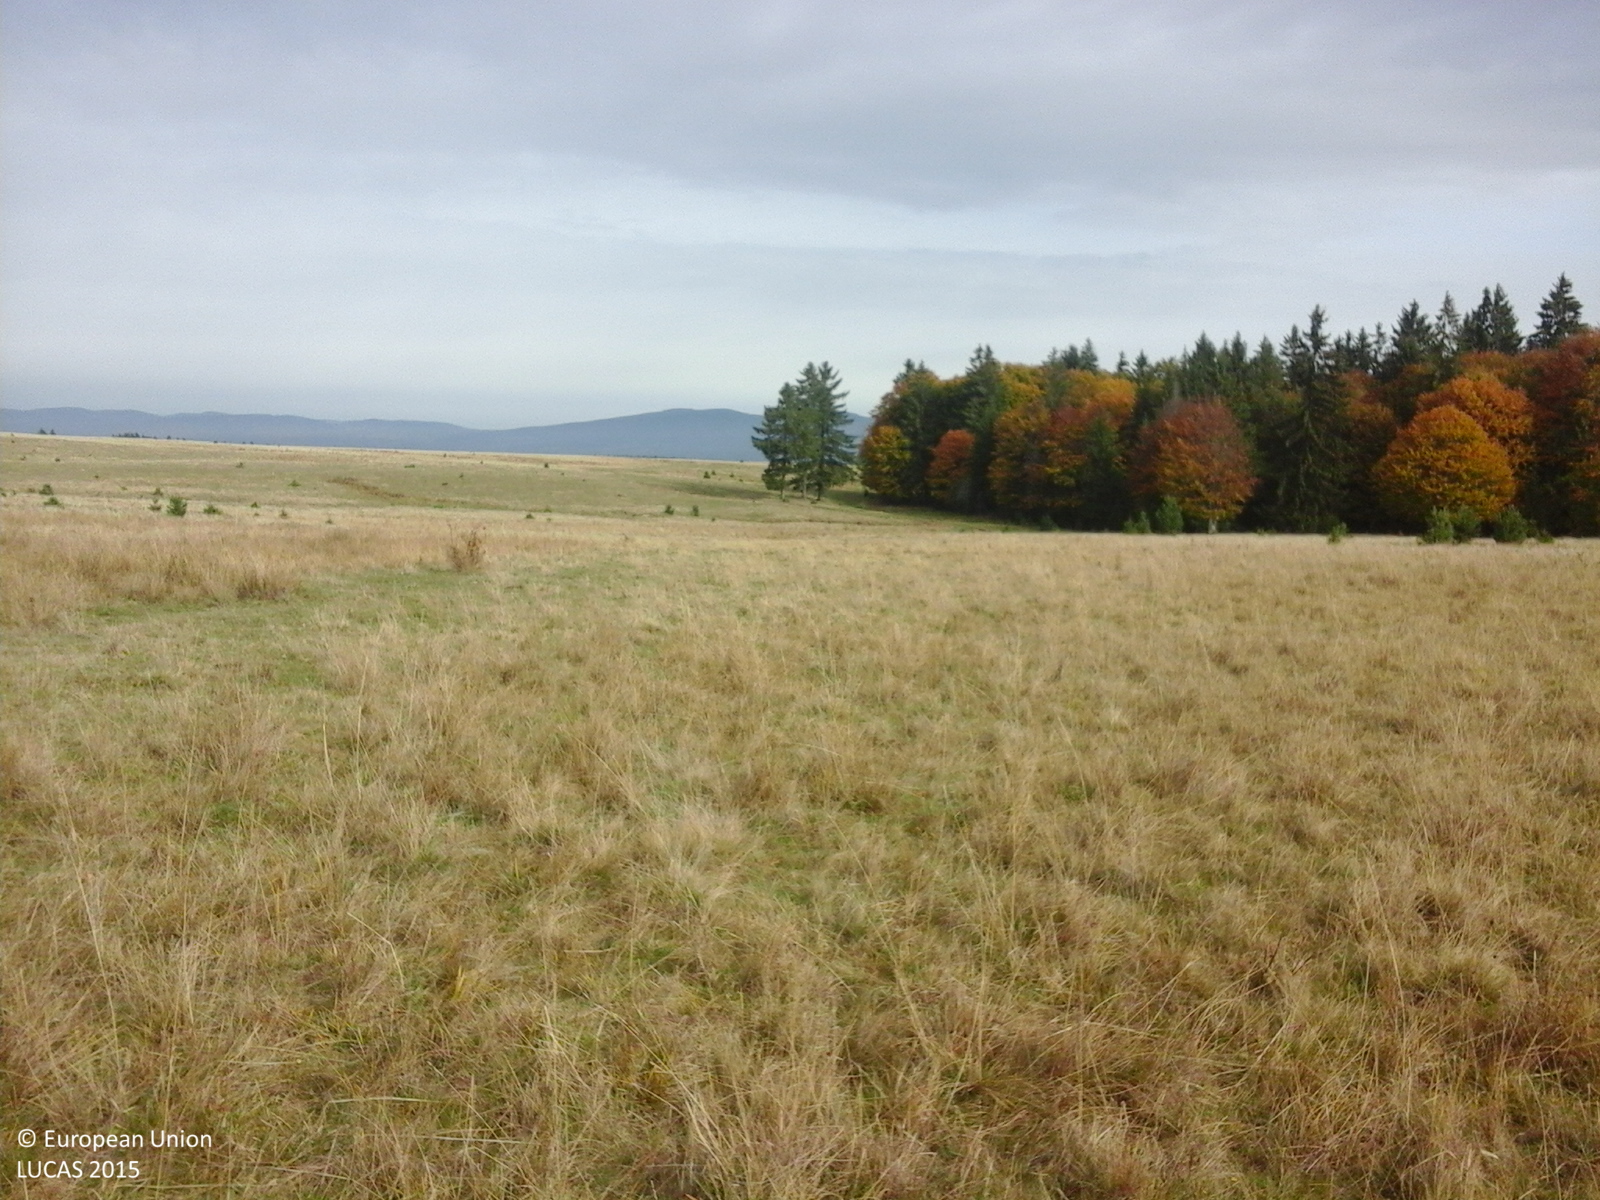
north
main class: Grassland
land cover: Grassland without tree/shrub cover
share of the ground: > 75 %
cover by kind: herbaceous plants 100 %
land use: Agriculture (excluding fallow land and kitchen gardens)
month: October
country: RO
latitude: 46.4268
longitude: 25.3426
